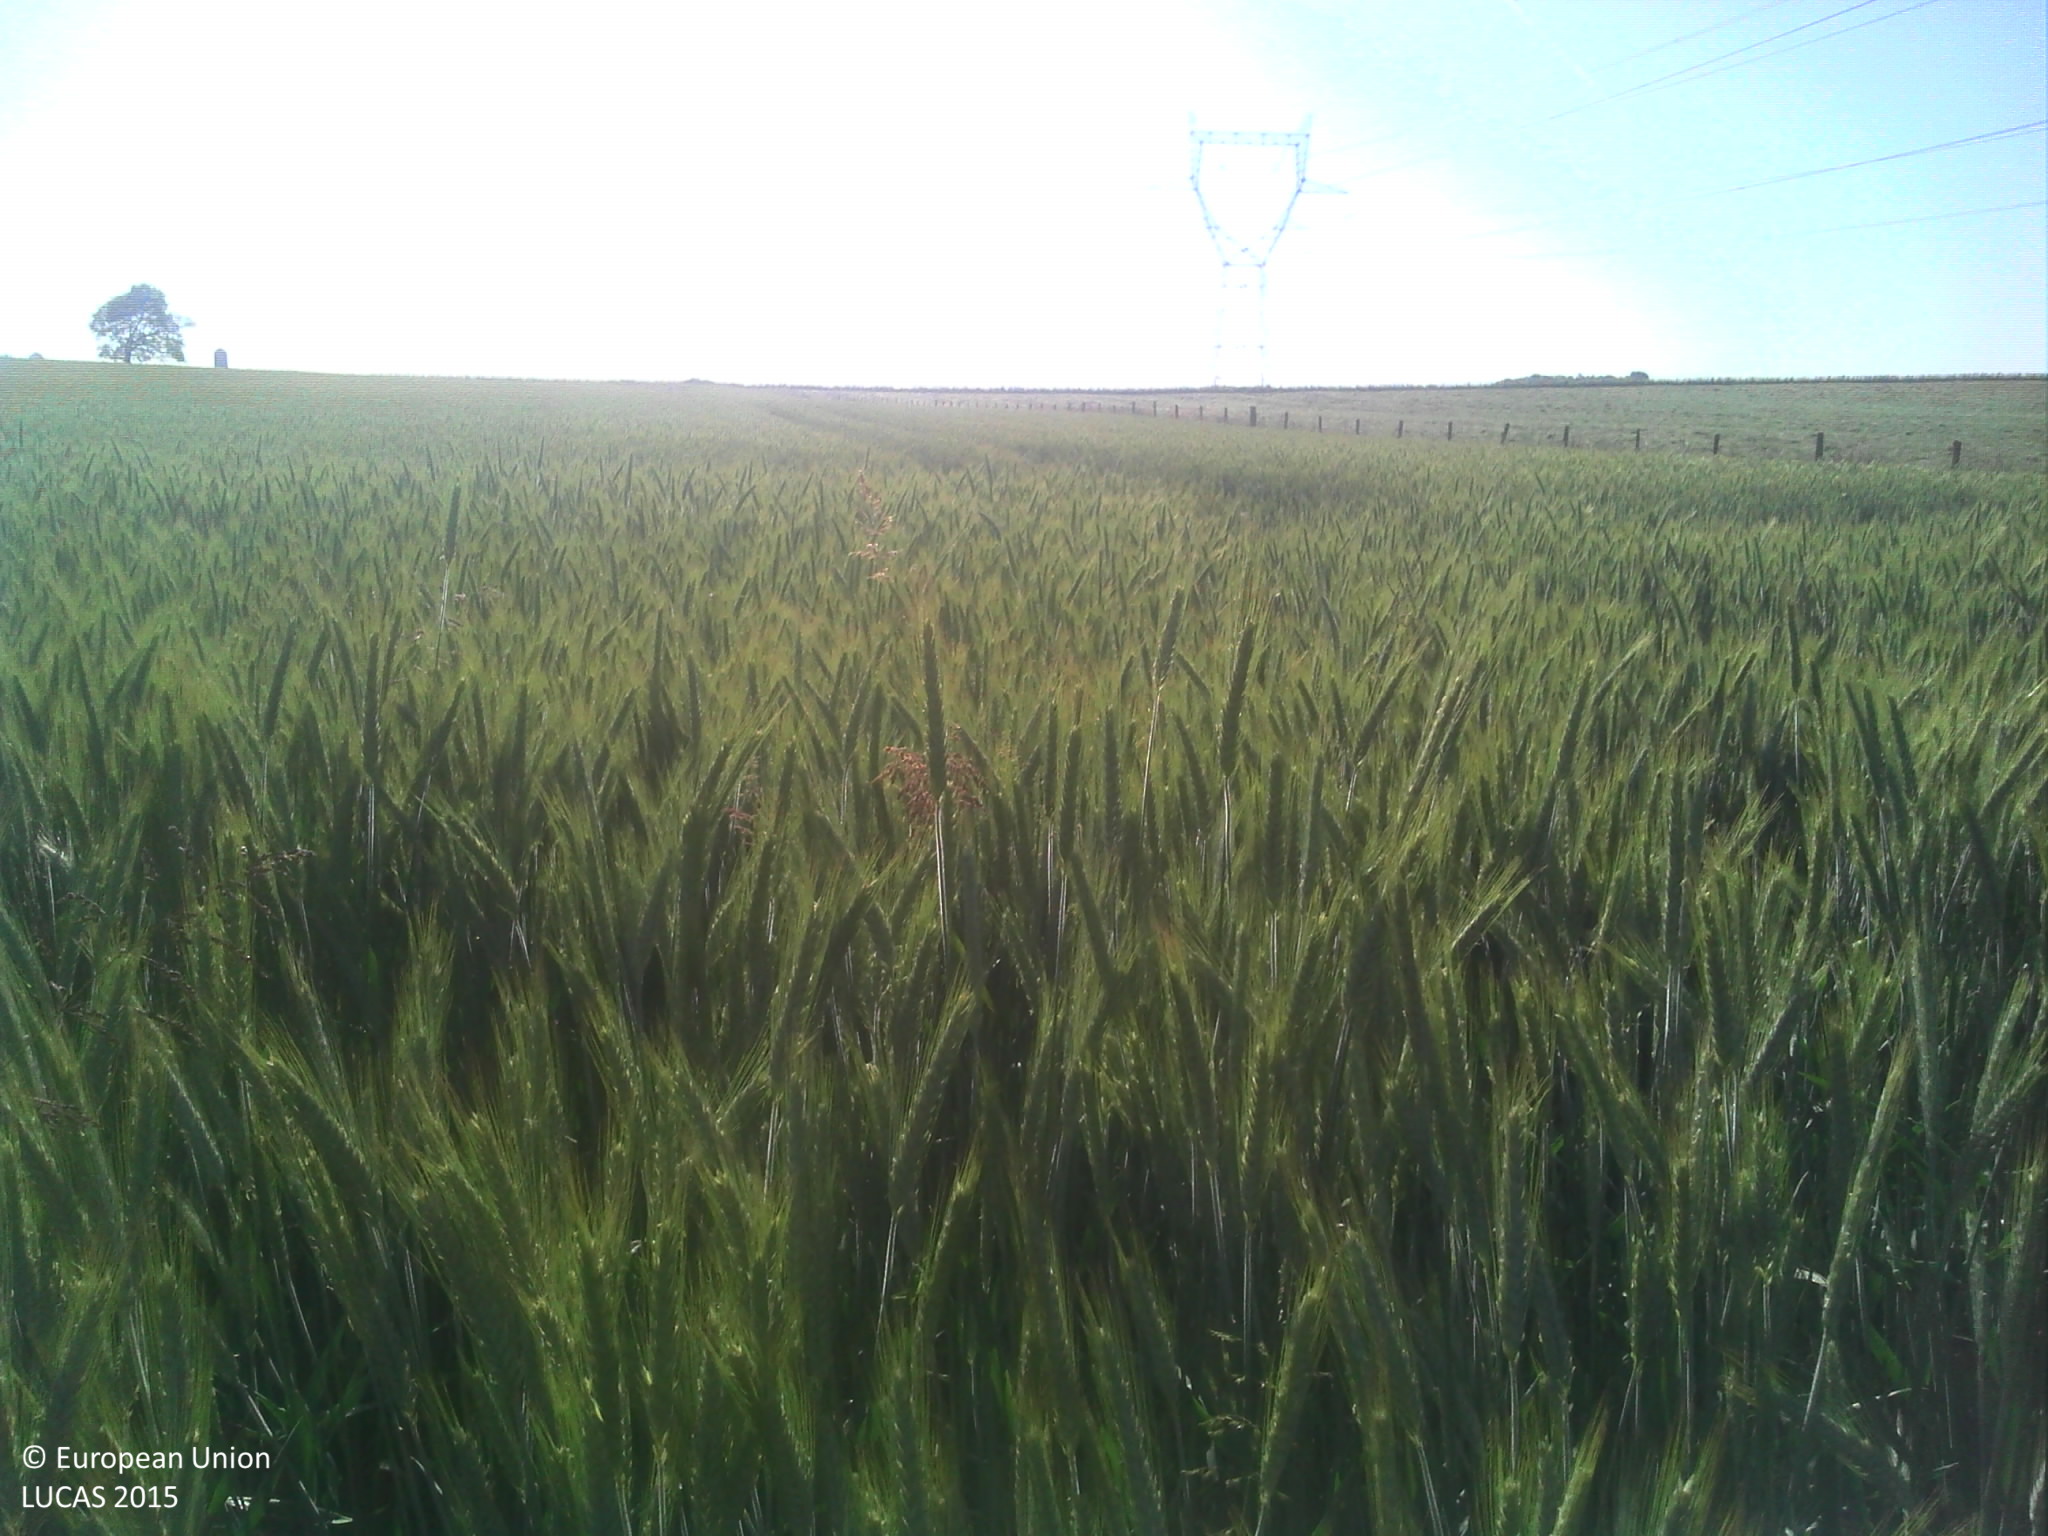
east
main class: Cropland
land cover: Triticale
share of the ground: > 75 %
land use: Agriculture (excluding fallow land and kitchen gardens)
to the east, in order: Grass margins; Triticale
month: June
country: FR
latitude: 48.5098
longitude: 4.6779
